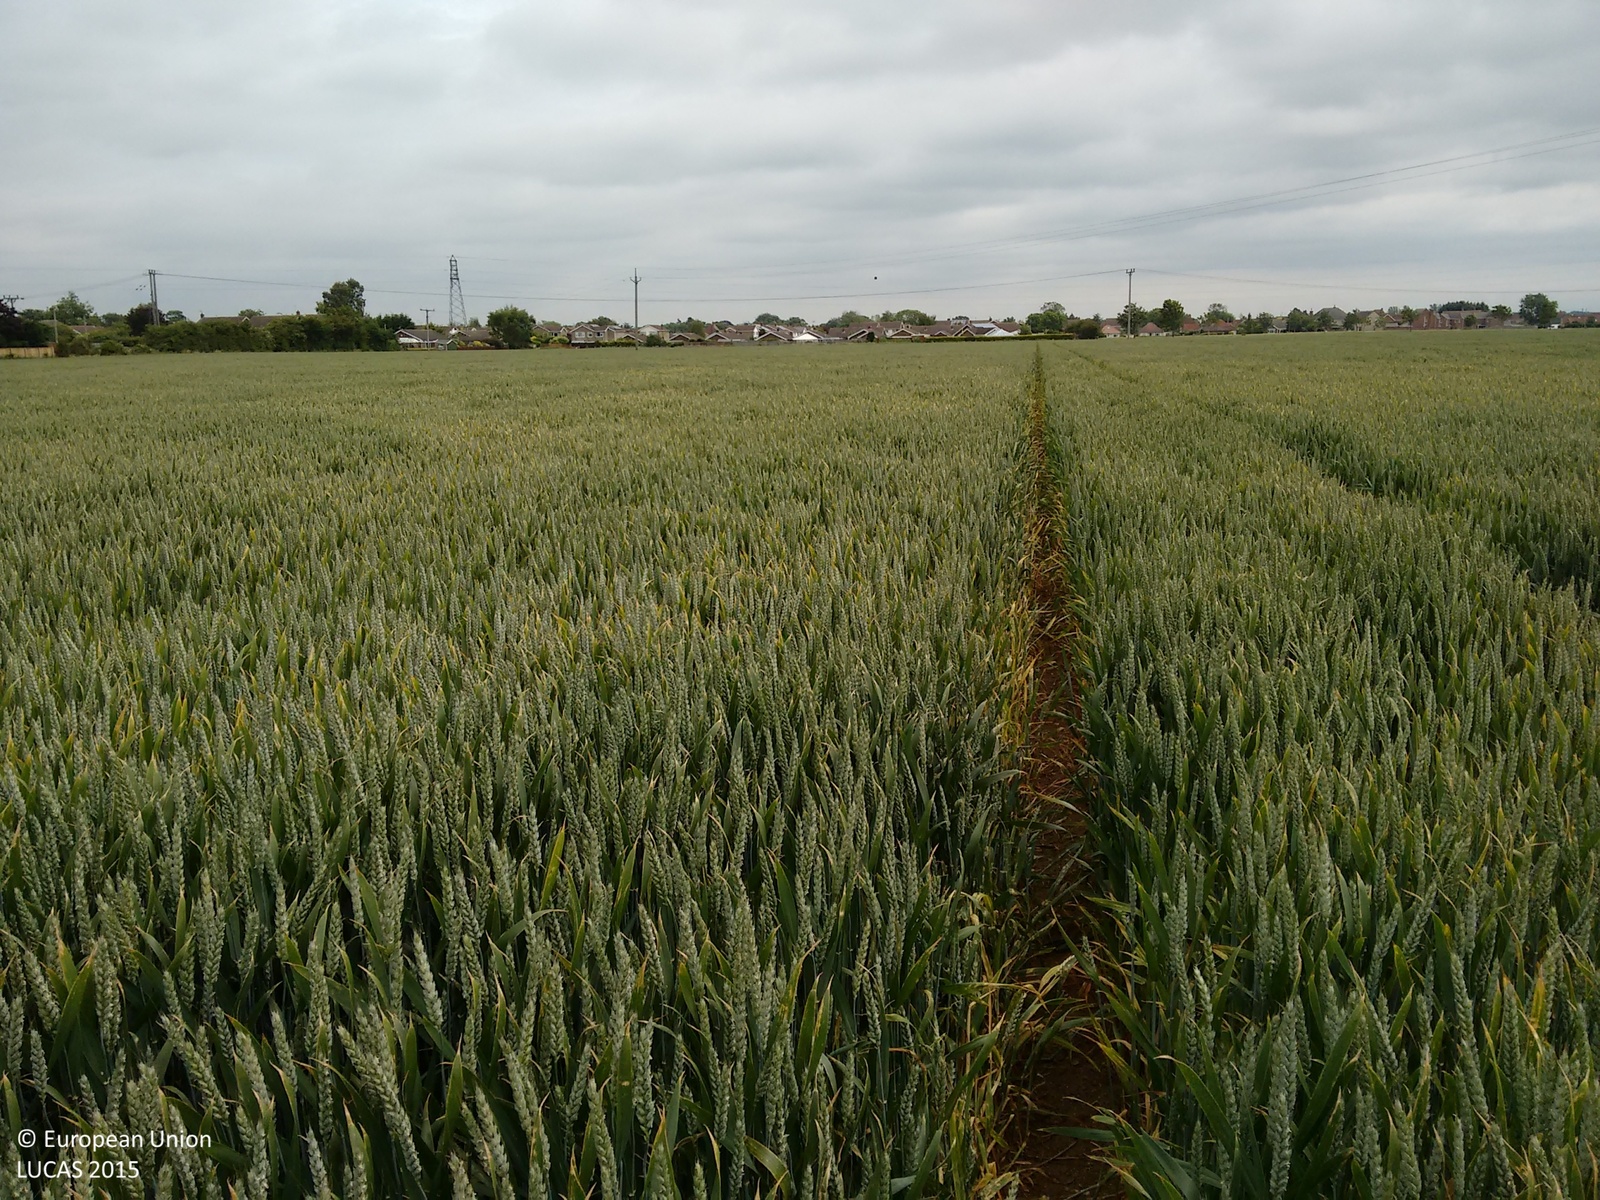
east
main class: Cropland
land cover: Common wheat
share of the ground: > 75 %
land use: Agriculture (excluding fallow land and kitchen gardens)
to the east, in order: Common wheat; Electric lines; Common wheat; Electric lines; Common wheat
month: June
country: GB
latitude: 53.0433
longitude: -0.4029
